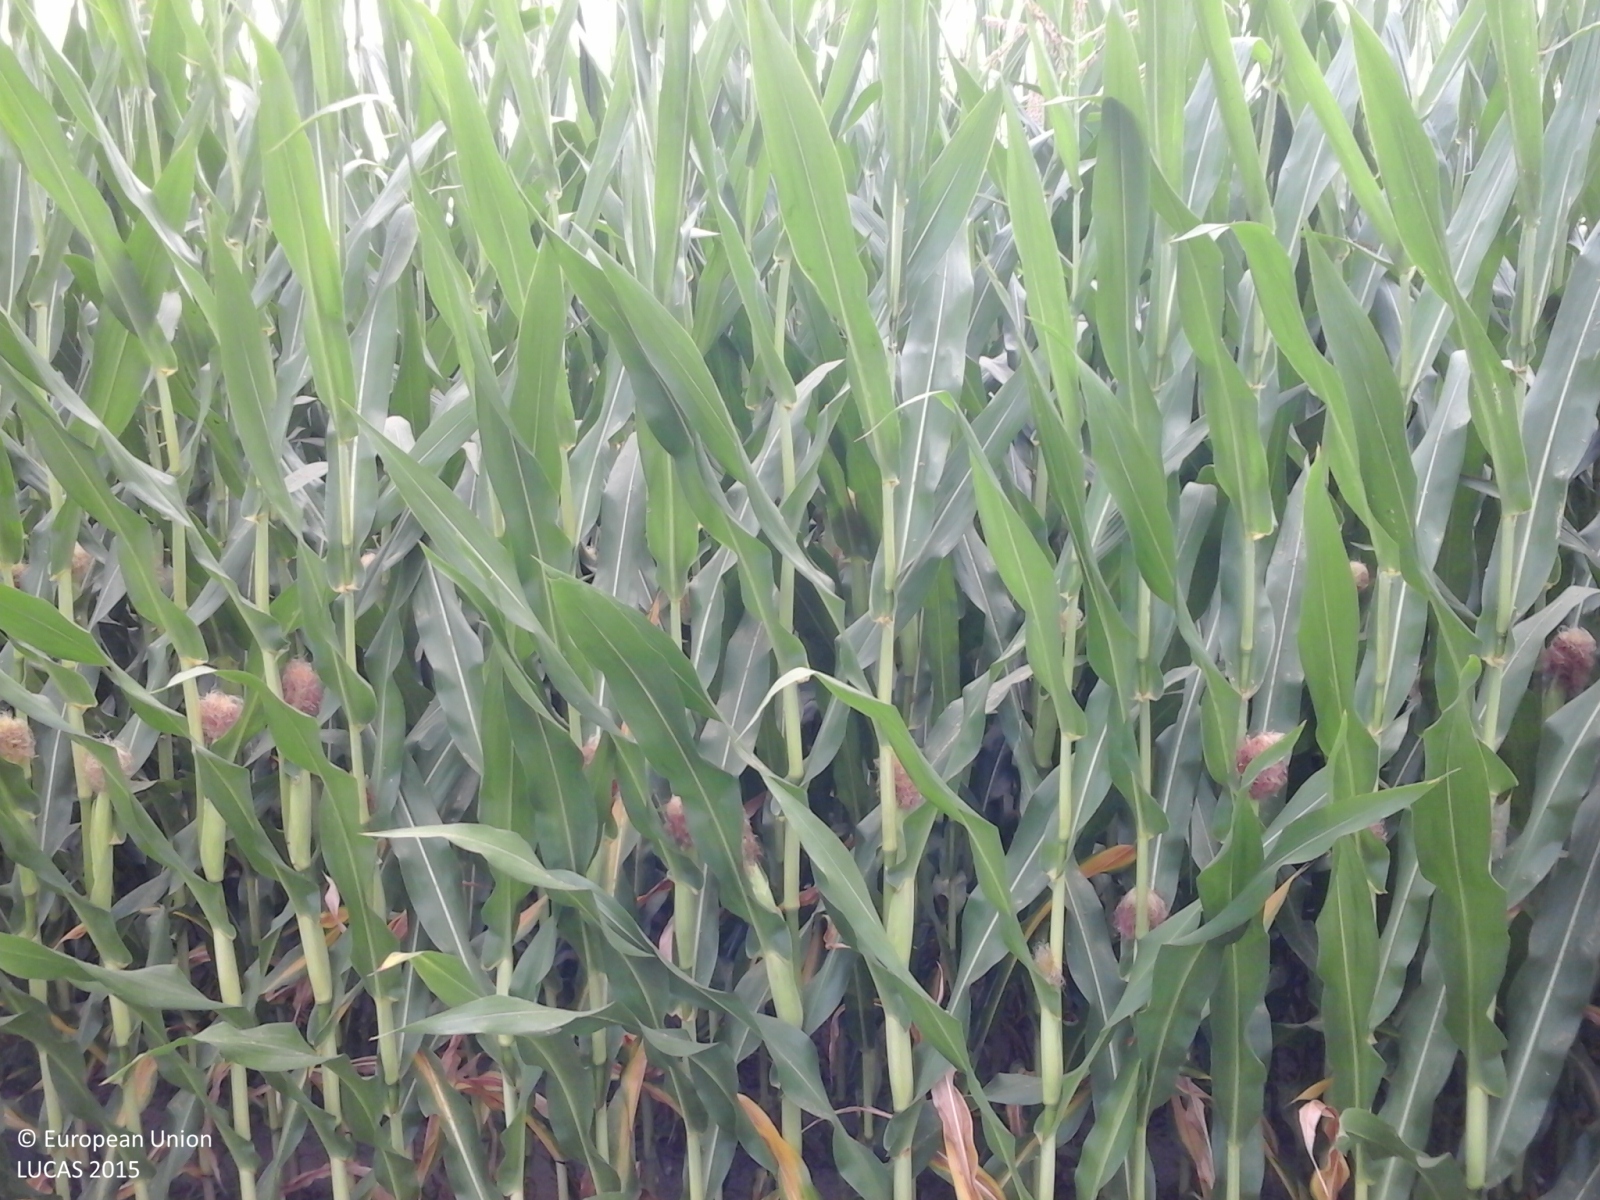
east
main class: Cropland
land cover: Maize
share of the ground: > 75 %
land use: Agriculture (excluding fallow land and kitchen gardens)
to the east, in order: Maize; Grass margins; Maize; Grassland without tree/shrub cover
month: July
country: IT
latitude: 45.2812
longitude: 8.7911
